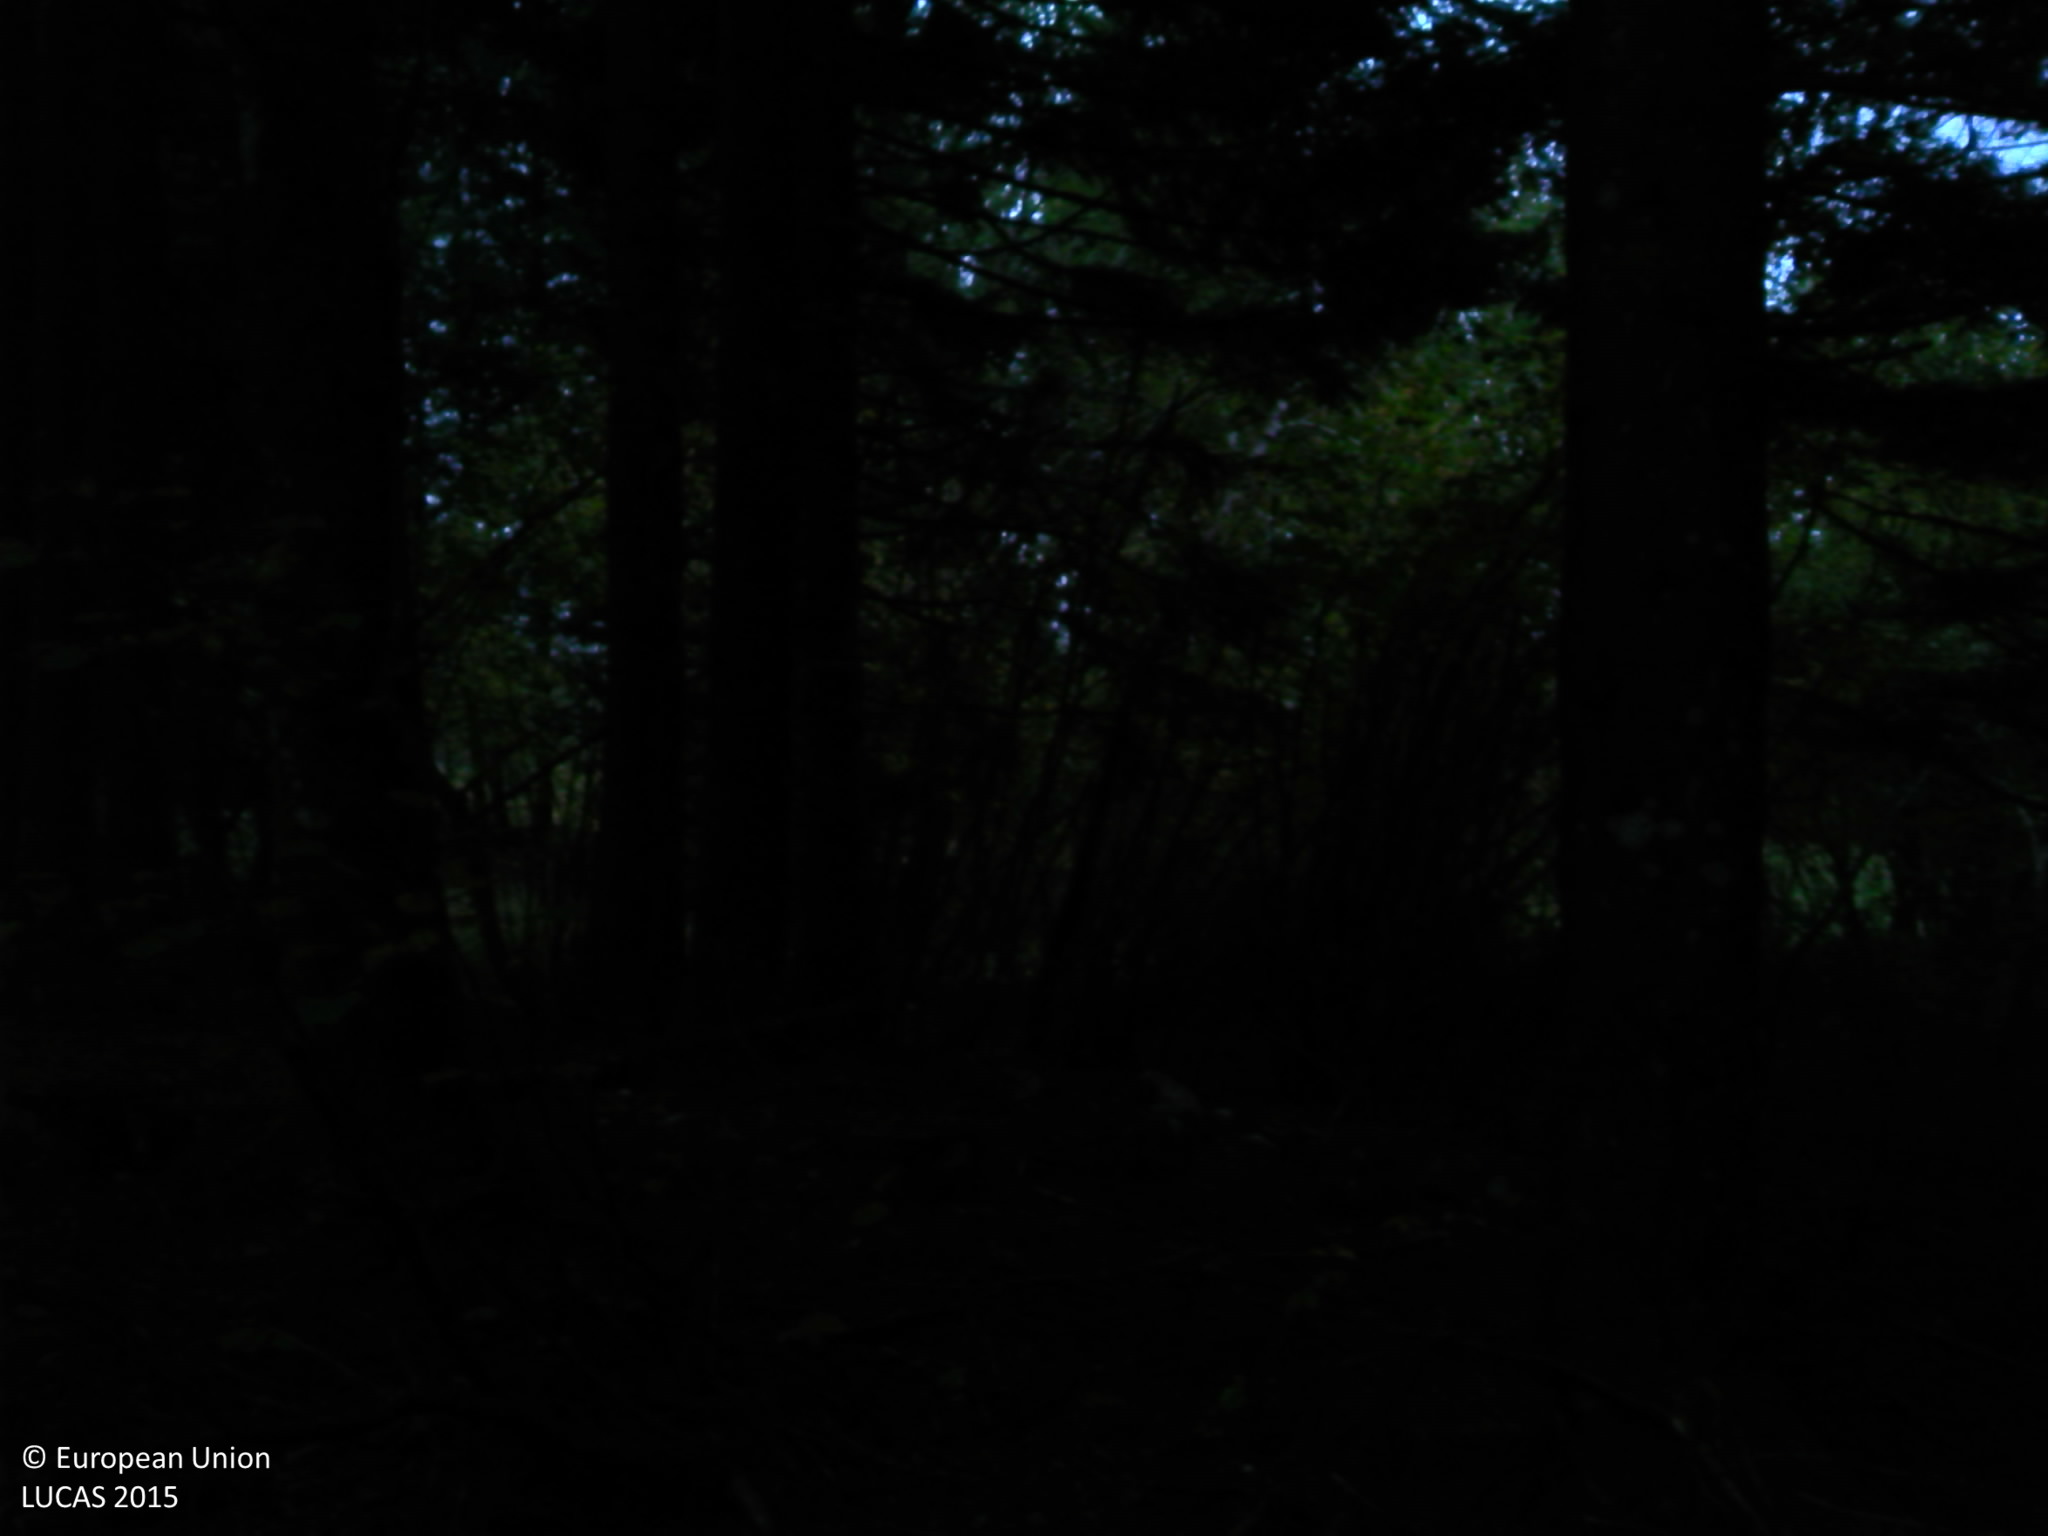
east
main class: Woodland
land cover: Spruce dominated mixed woodland
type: mountainous beech forest
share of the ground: > 75 %
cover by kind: coniferous forest trees 40 %, broadleaved forest trees 40 %, shrubs 20 %
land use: Forestry
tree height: > 5 m
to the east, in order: Spruce dominated mixed woodland; Tracks; Spruce dominated coniferous woodland; Fences; Grassland without tree/shrub cover; Broadleaved woodland; Grassland without tree/shrub cover; Broadleaved woodland; Grassland without tree/shrub cover; Broadleaved woodland; Fences; Broadleaved woodland
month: October
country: FR
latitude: 46.8583
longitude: 6.1330
